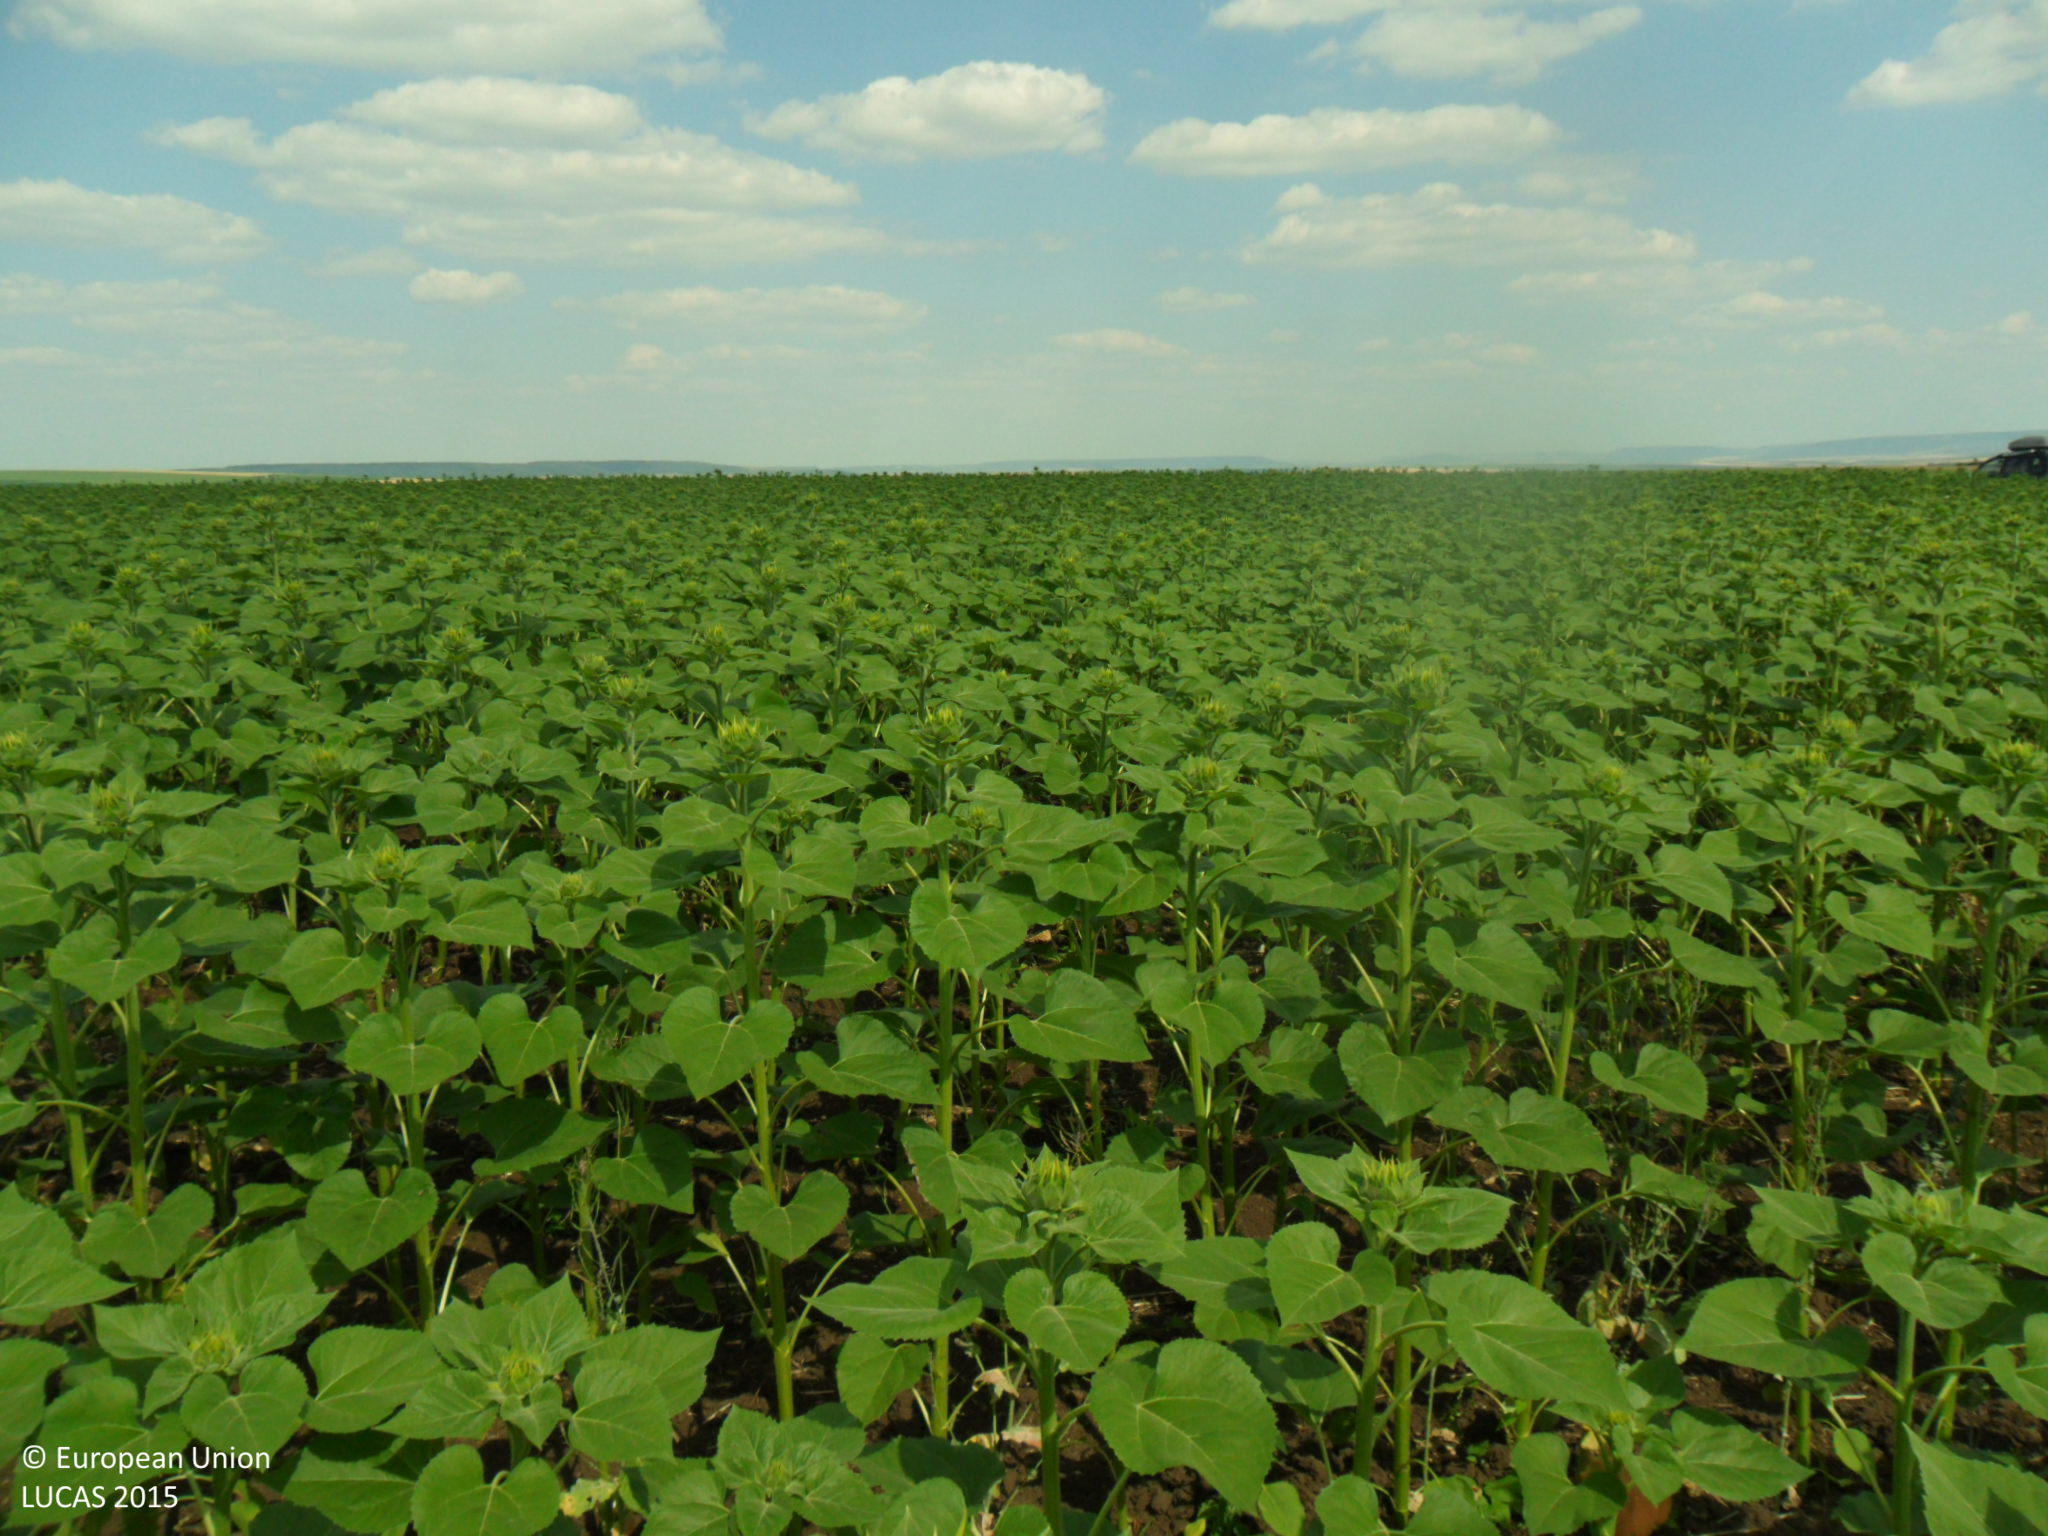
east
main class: Cropland
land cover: Sunflower
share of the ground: > 75 %
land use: Agriculture (excluding fallow land and kitchen gardens)
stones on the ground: < 10 %
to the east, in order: Sunflower
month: June
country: BG
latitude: 43.4477
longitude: 26.9072
